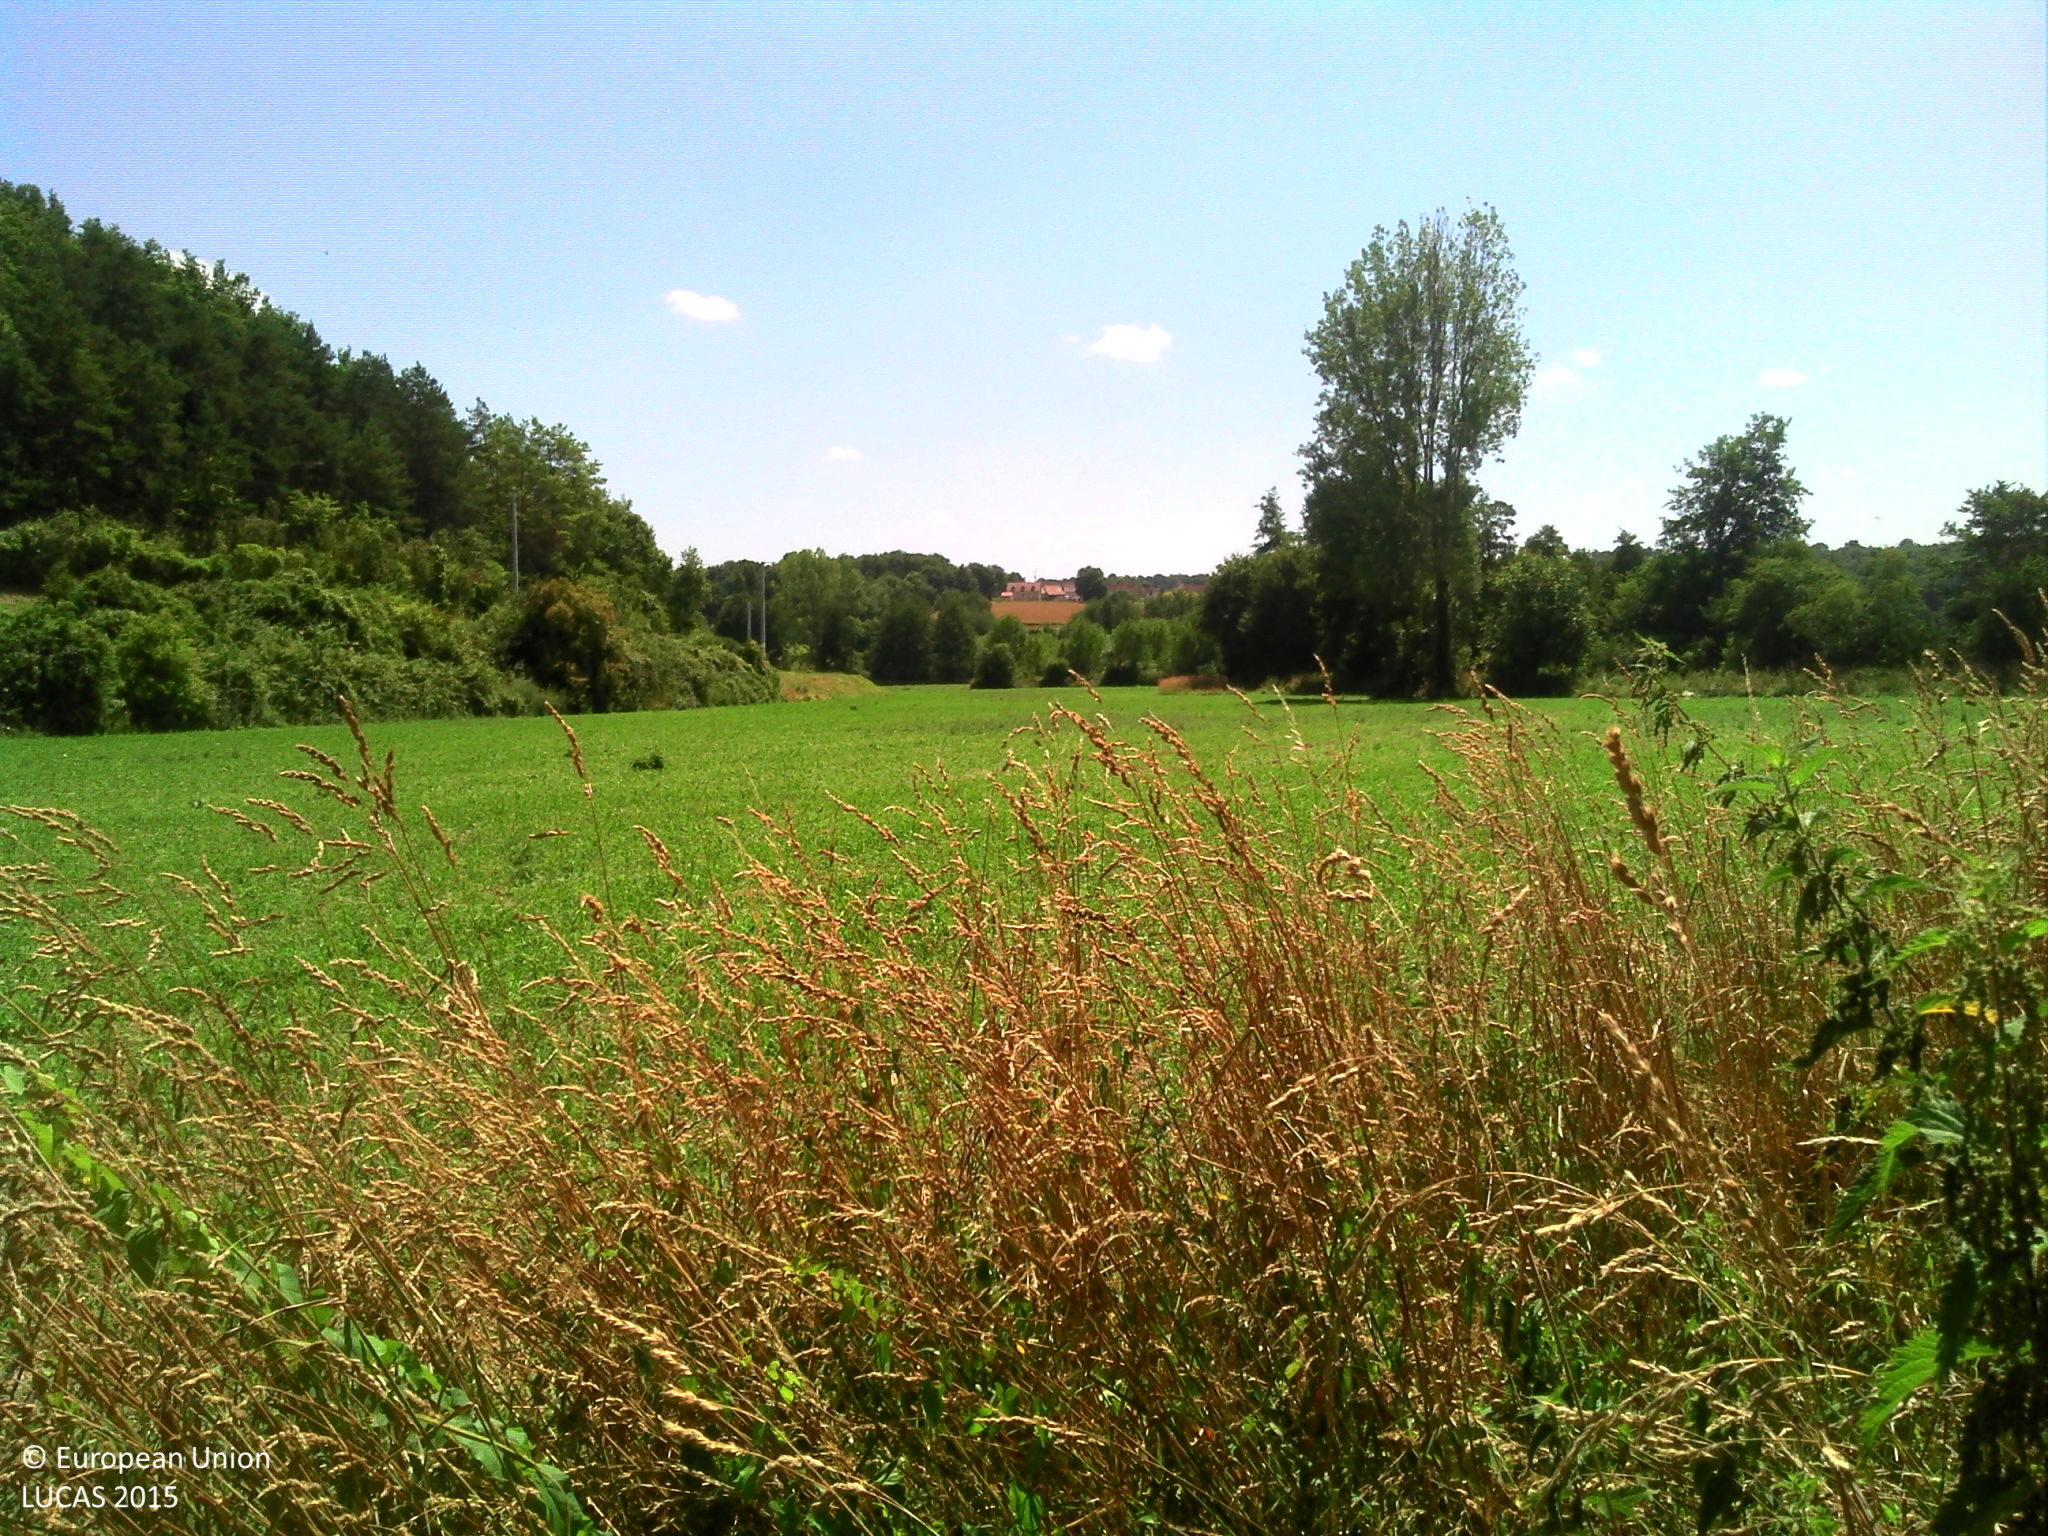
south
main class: Cropland
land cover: Maize
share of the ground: > 75 %
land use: Agriculture (excluding fallow land and kitchen gardens)
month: July
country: FR
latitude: 46.9215
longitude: 0.8834
